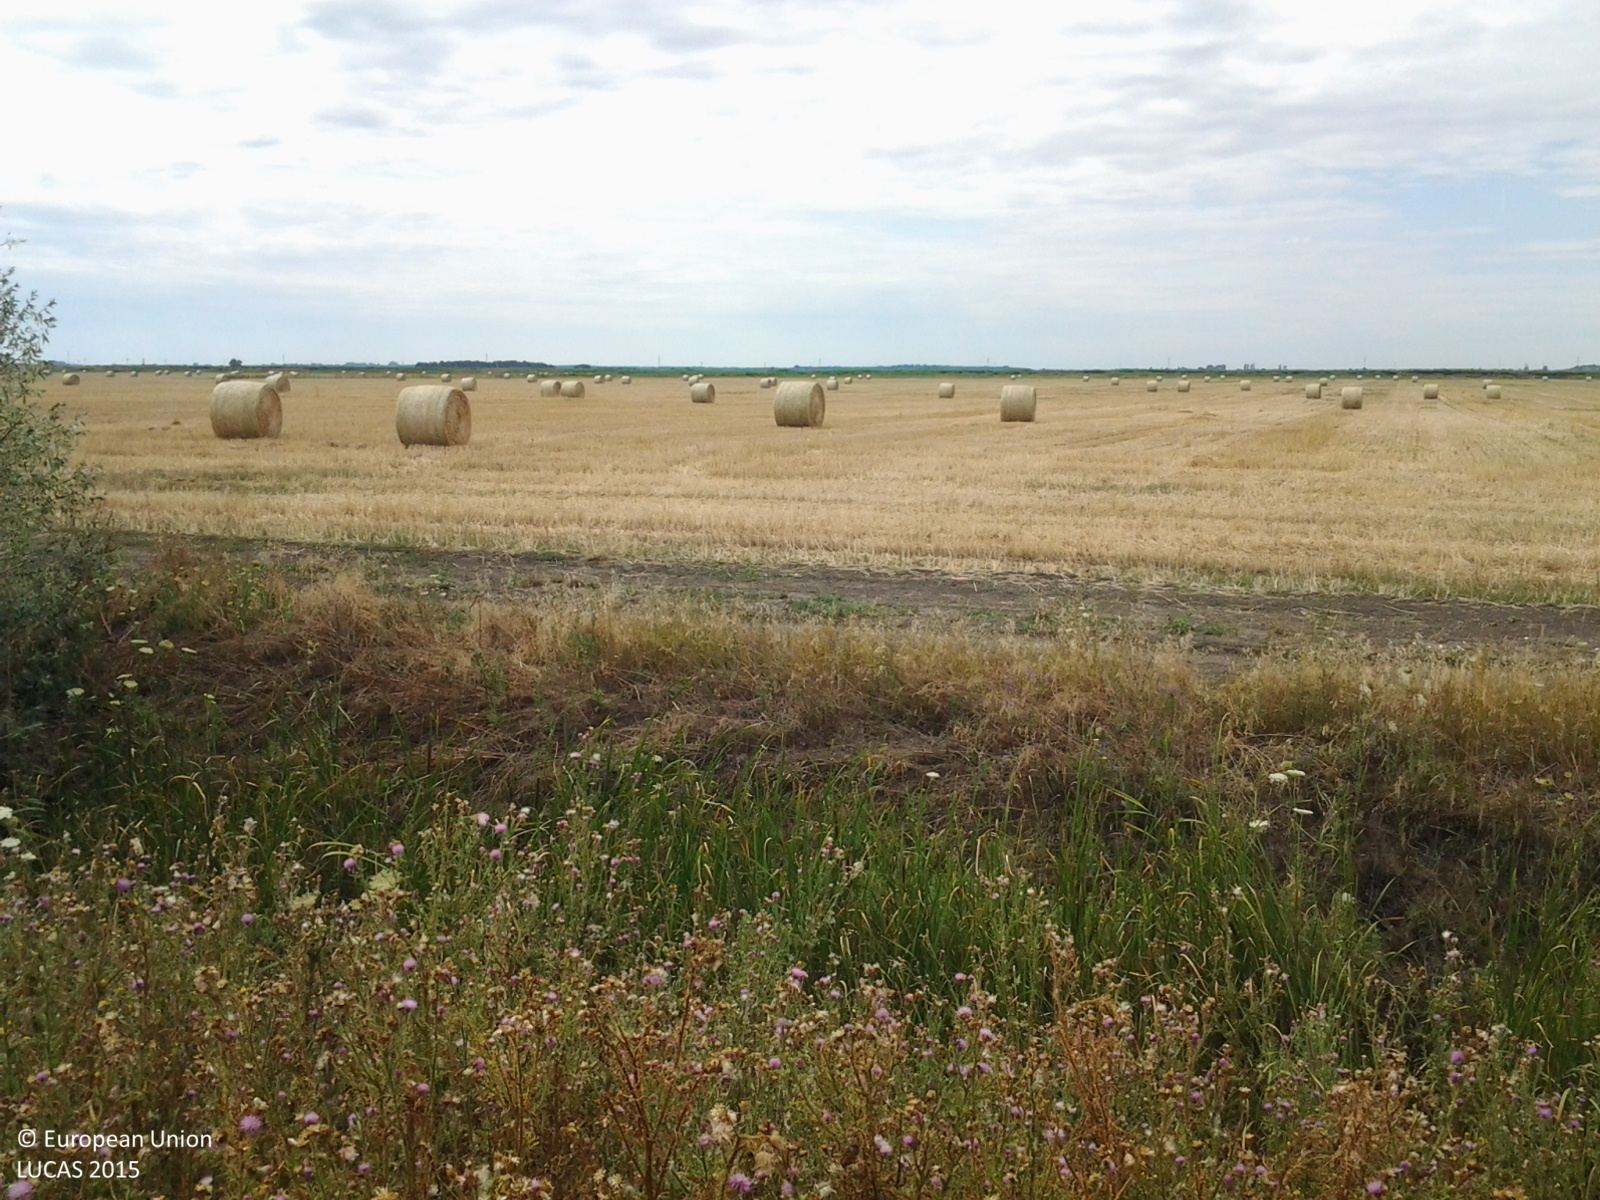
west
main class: Grassland
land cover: Spontaneously vegetated surfaces
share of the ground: > 75 %
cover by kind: herbaceous plants 100 %
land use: Semi-natural and natural areas not in use
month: July
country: HU
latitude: 47.2297
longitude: 20.8775
